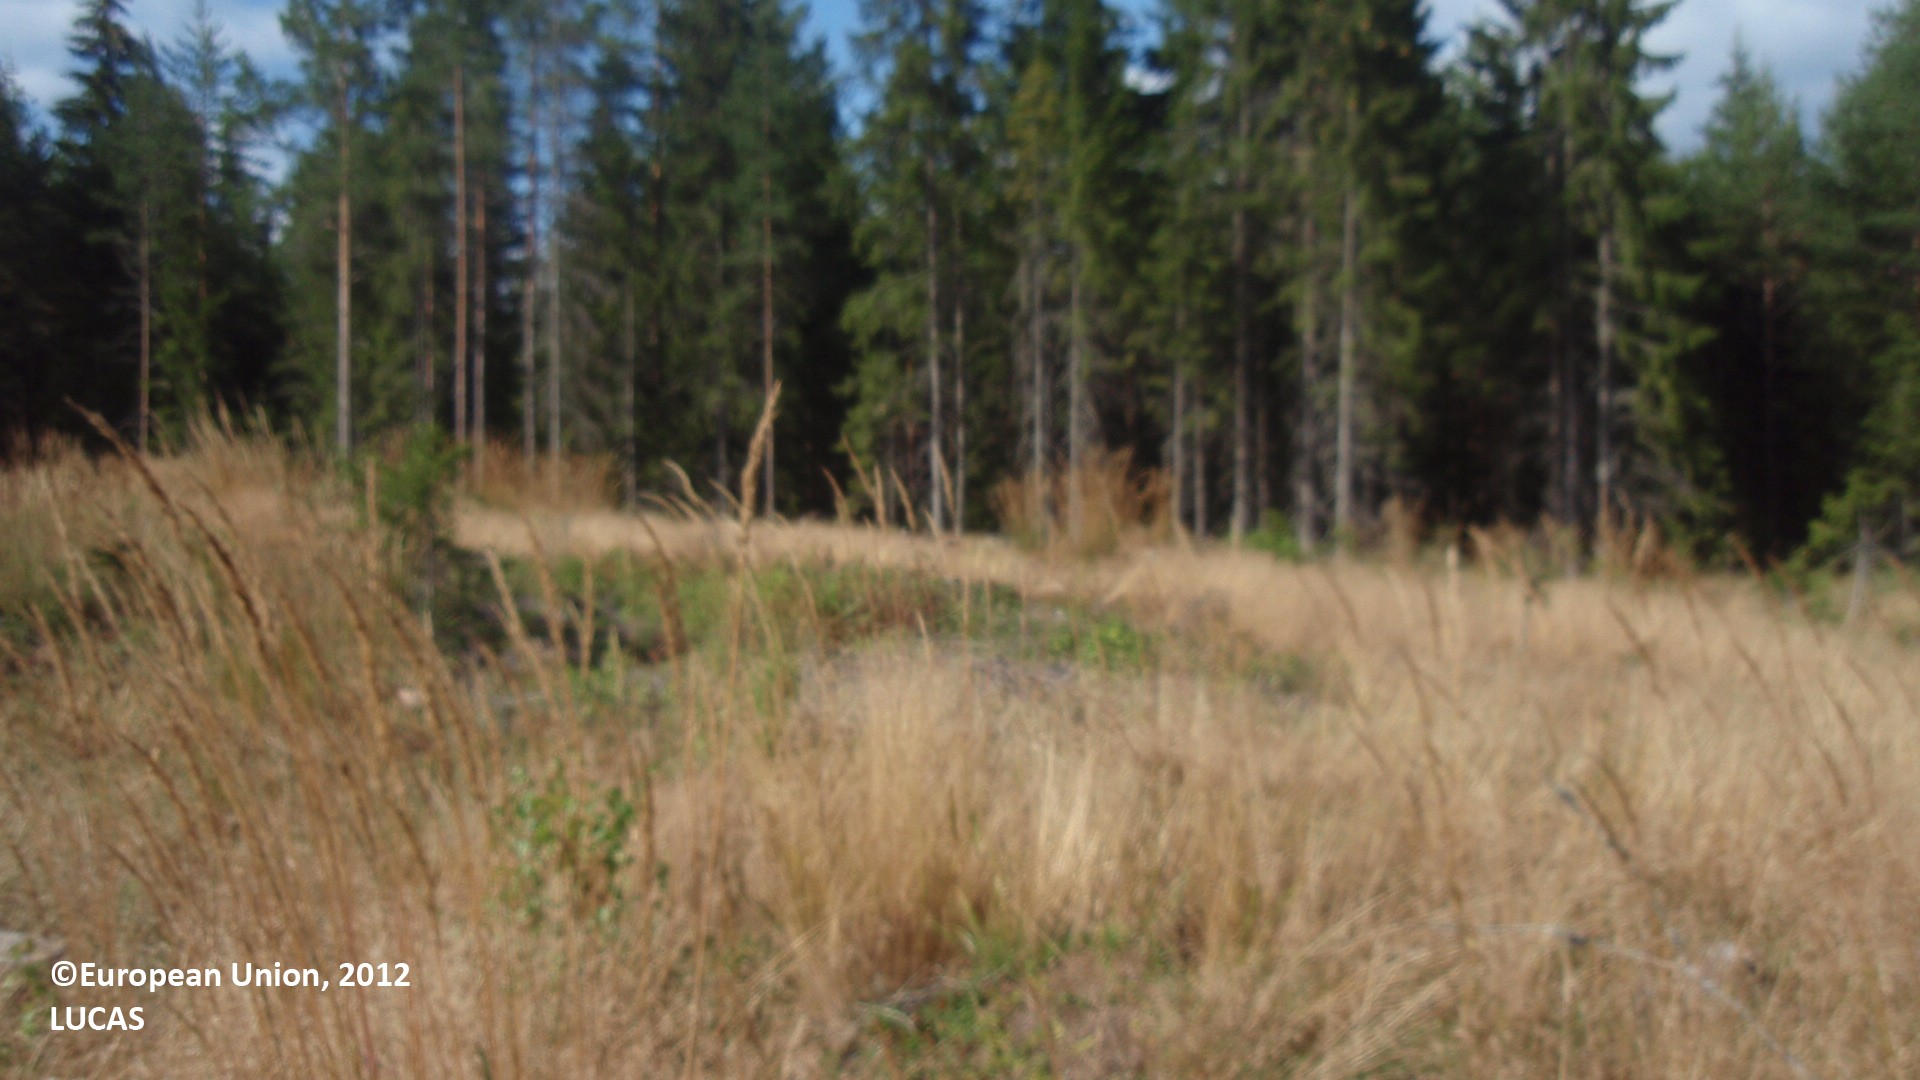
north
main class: Grassland
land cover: Grassland with sparse tree/shrub cover
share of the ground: 50 - 75 %
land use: Forestry
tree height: > 5 m
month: August
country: FI
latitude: 60.7246
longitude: 27.4712
